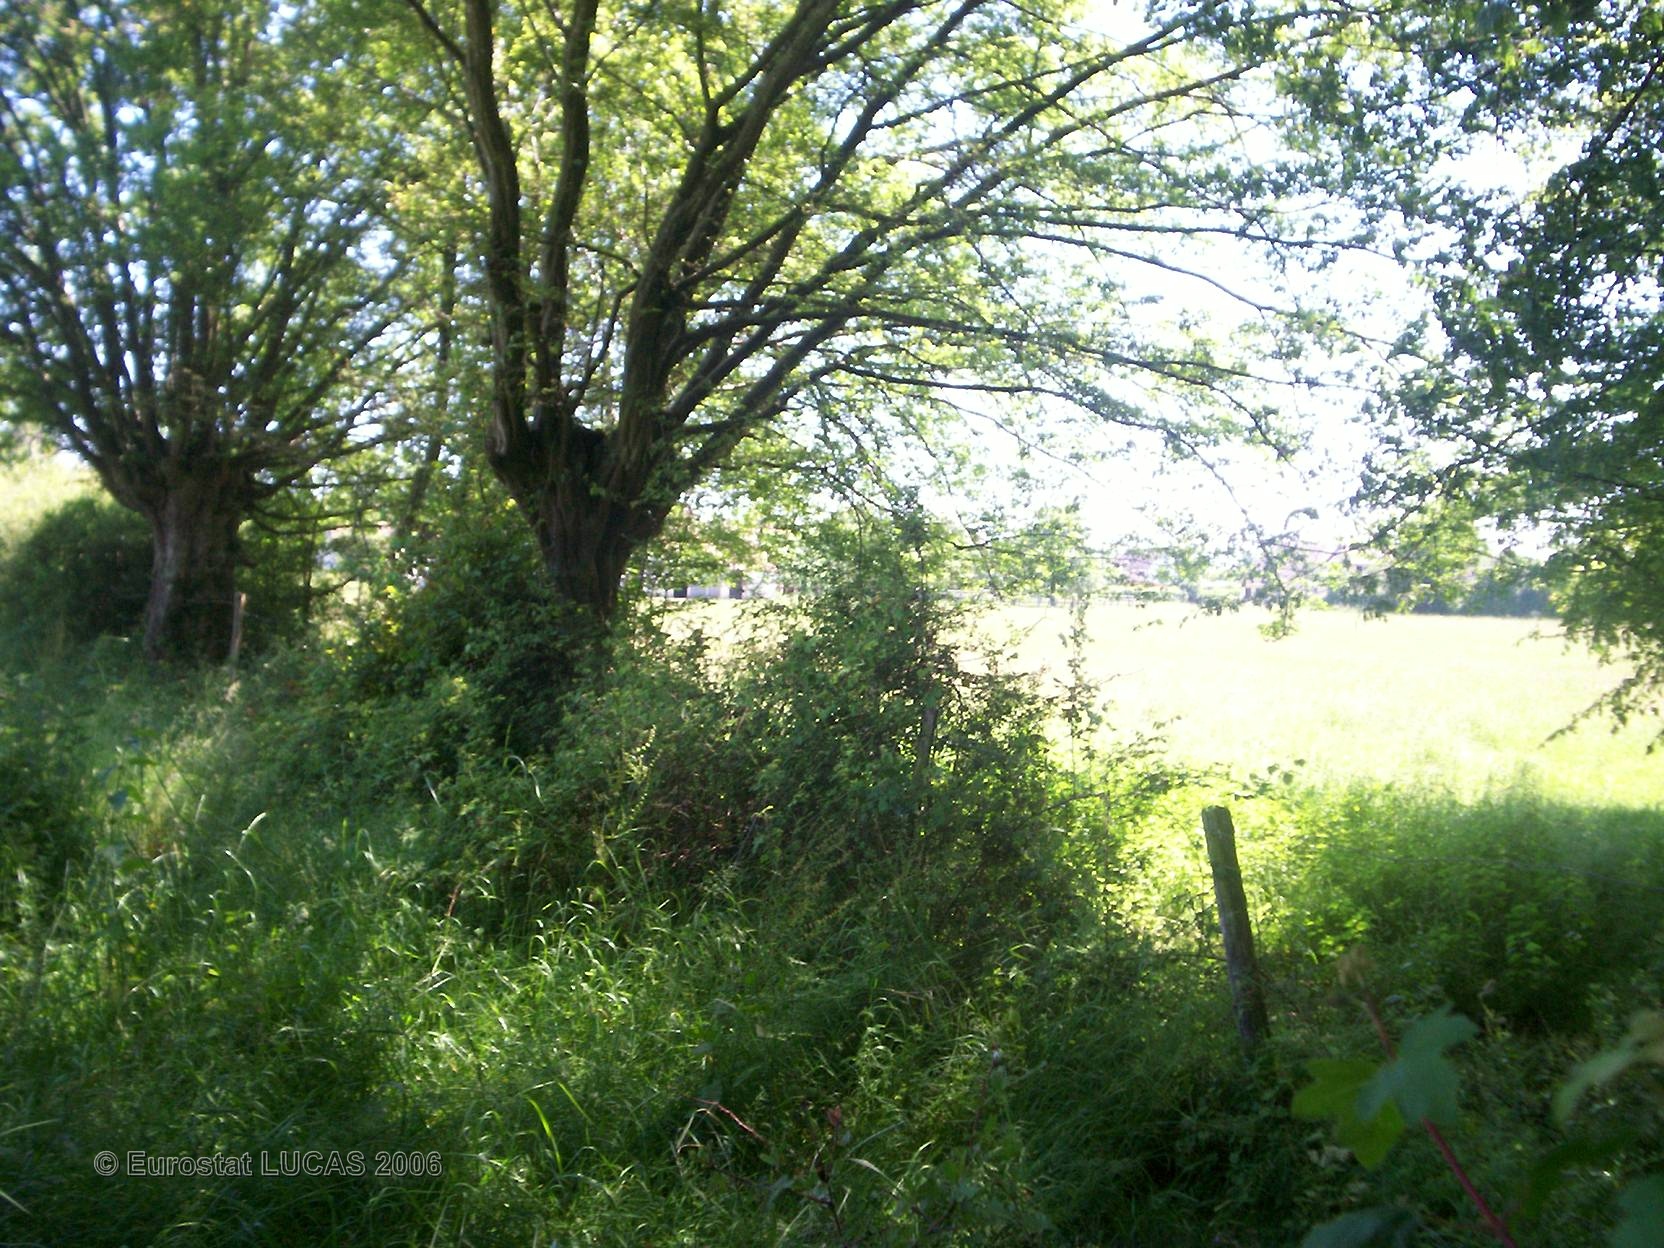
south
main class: Grassland
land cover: Grassland with sparse tree/shrub cover
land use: Agriculture (excluding fallow land and kitchen gardens)
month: June
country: FR
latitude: 46.9560
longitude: 3.0447
